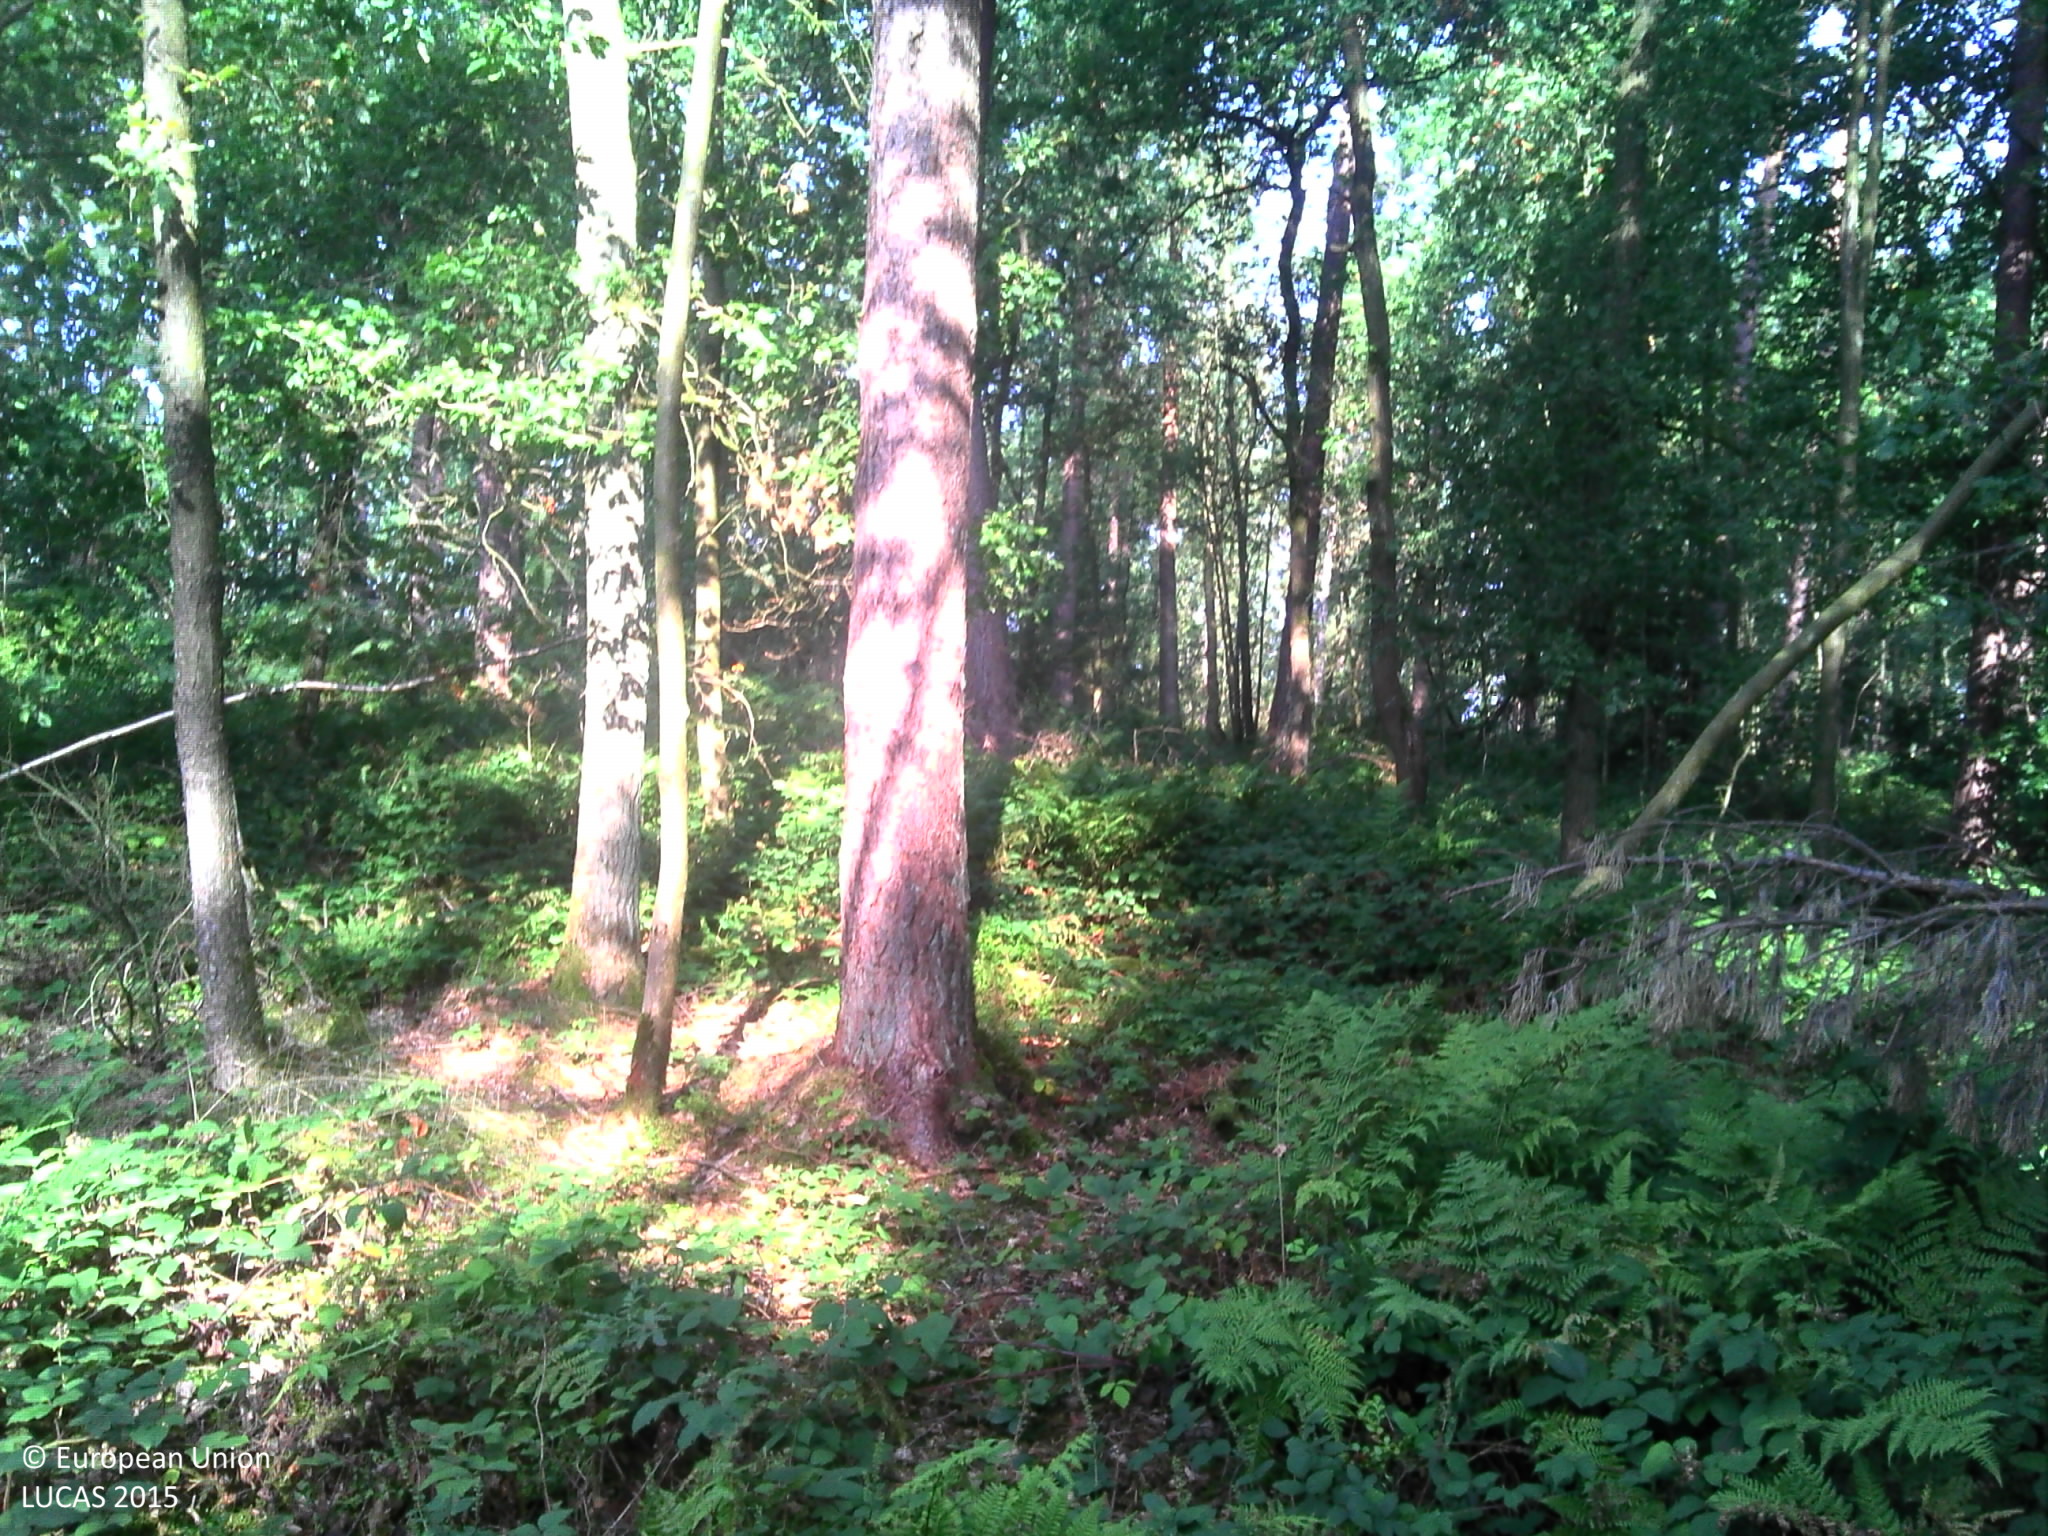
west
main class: Woodland
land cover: Pine dominated mixed woodland
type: hemiboreal forest and nemoral coniferous forest and mixed broadleaved-coniferous forest
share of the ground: > 75 %
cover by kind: coniferous forest trees 50 %, broadleaved forest trees 30 %, herbaceous plants 20 %
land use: Forestry
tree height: > 5 m
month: August
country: BE
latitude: 50.3314
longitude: 5.5450
